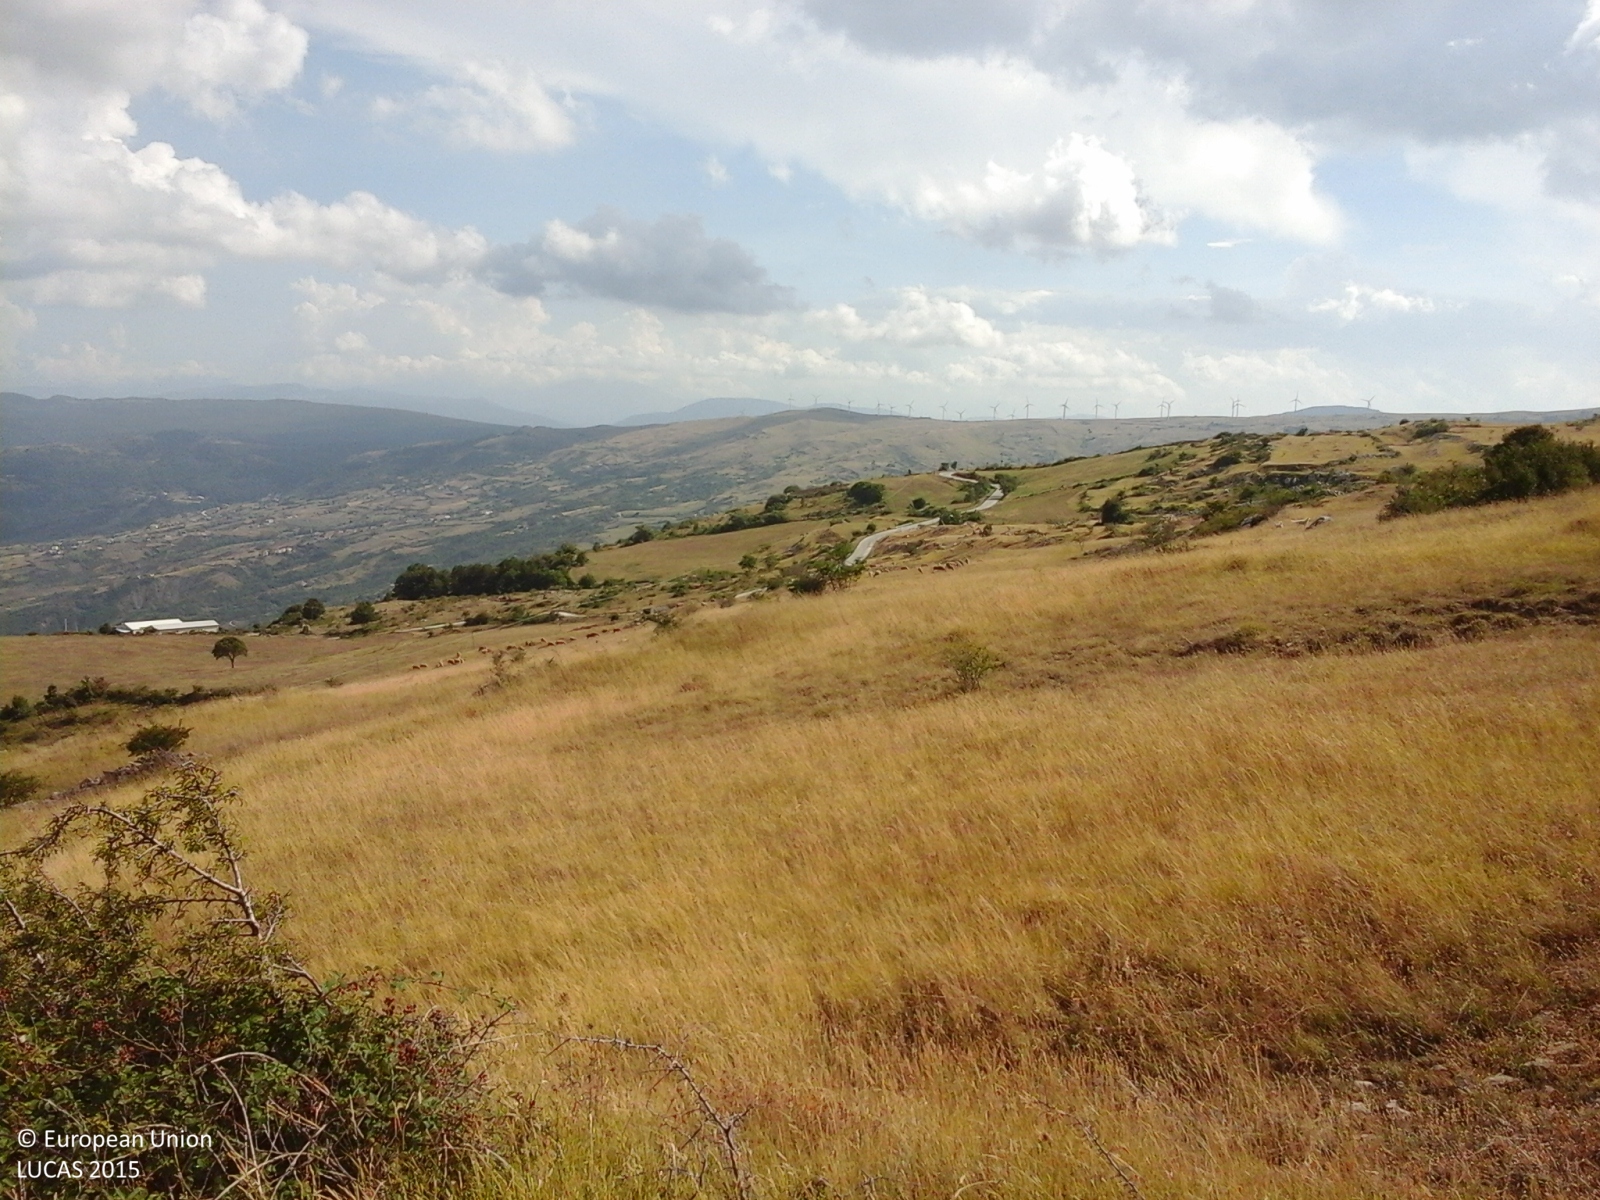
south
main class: Grassland
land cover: Grassland without tree/shrub cover
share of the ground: > 75 %
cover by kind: herbaceous plants 100 %
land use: Agriculture (excluding fallow land and kitchen gardens)
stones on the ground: 25 - 50 %
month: August
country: IT
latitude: 41.8388
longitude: 14.3087
